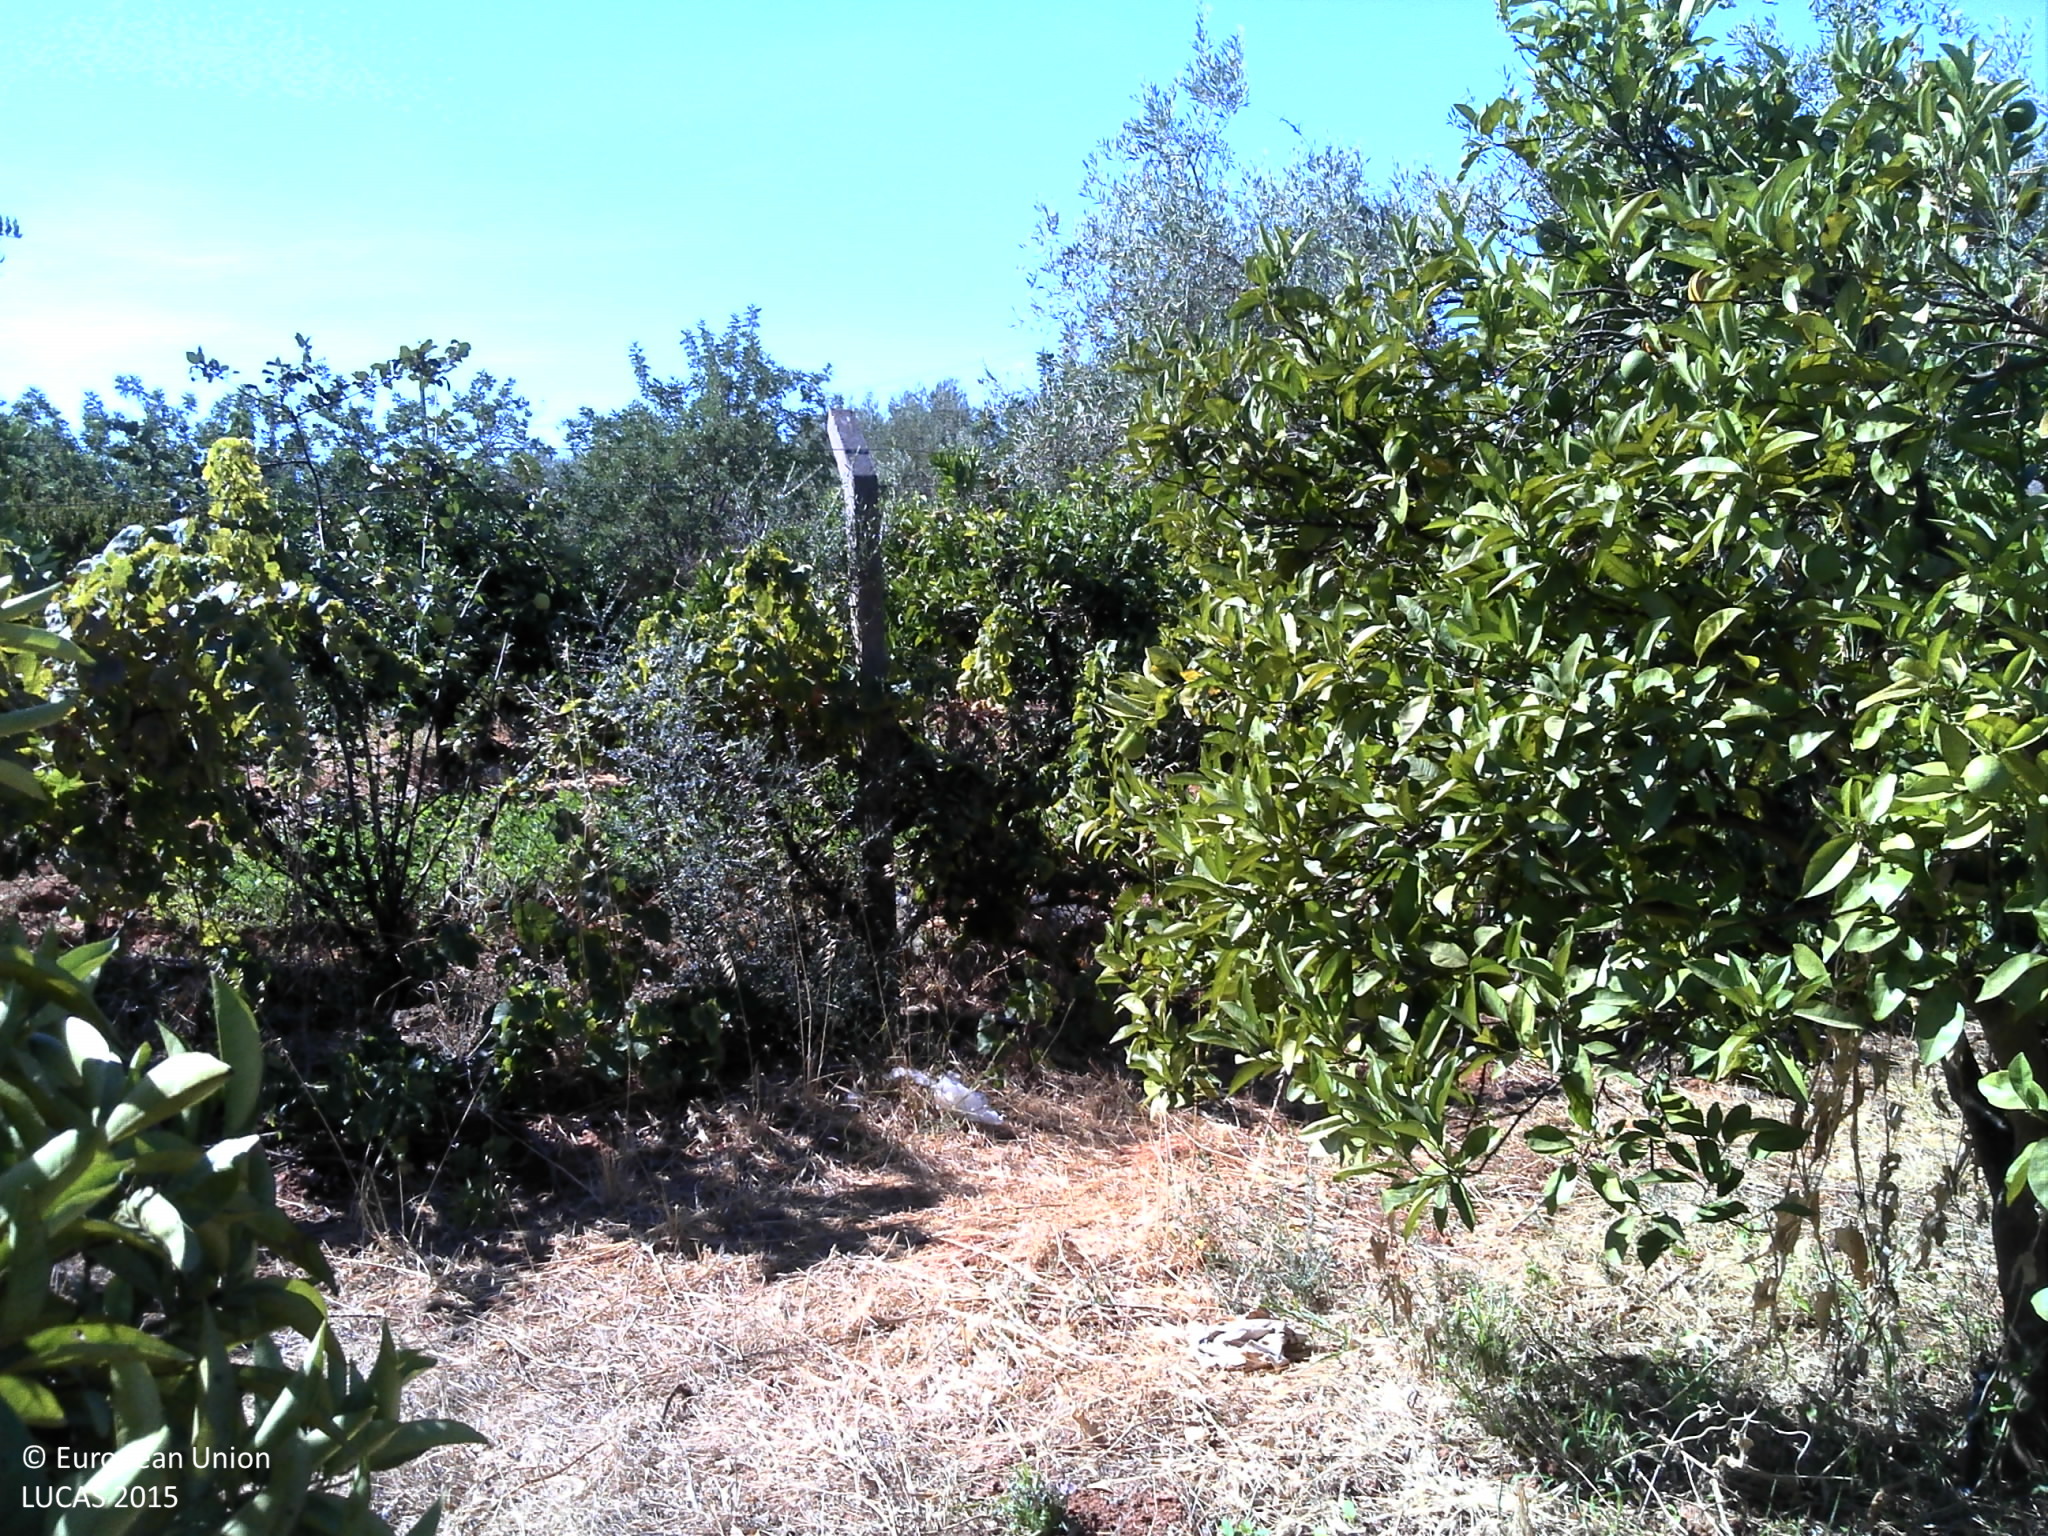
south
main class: Cropland
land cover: Oranges
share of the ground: 50 - 75 %
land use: Agriculture (excluding fallow land and kitchen gardens)
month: September
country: PT
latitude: 37.1115
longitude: -8.1679
